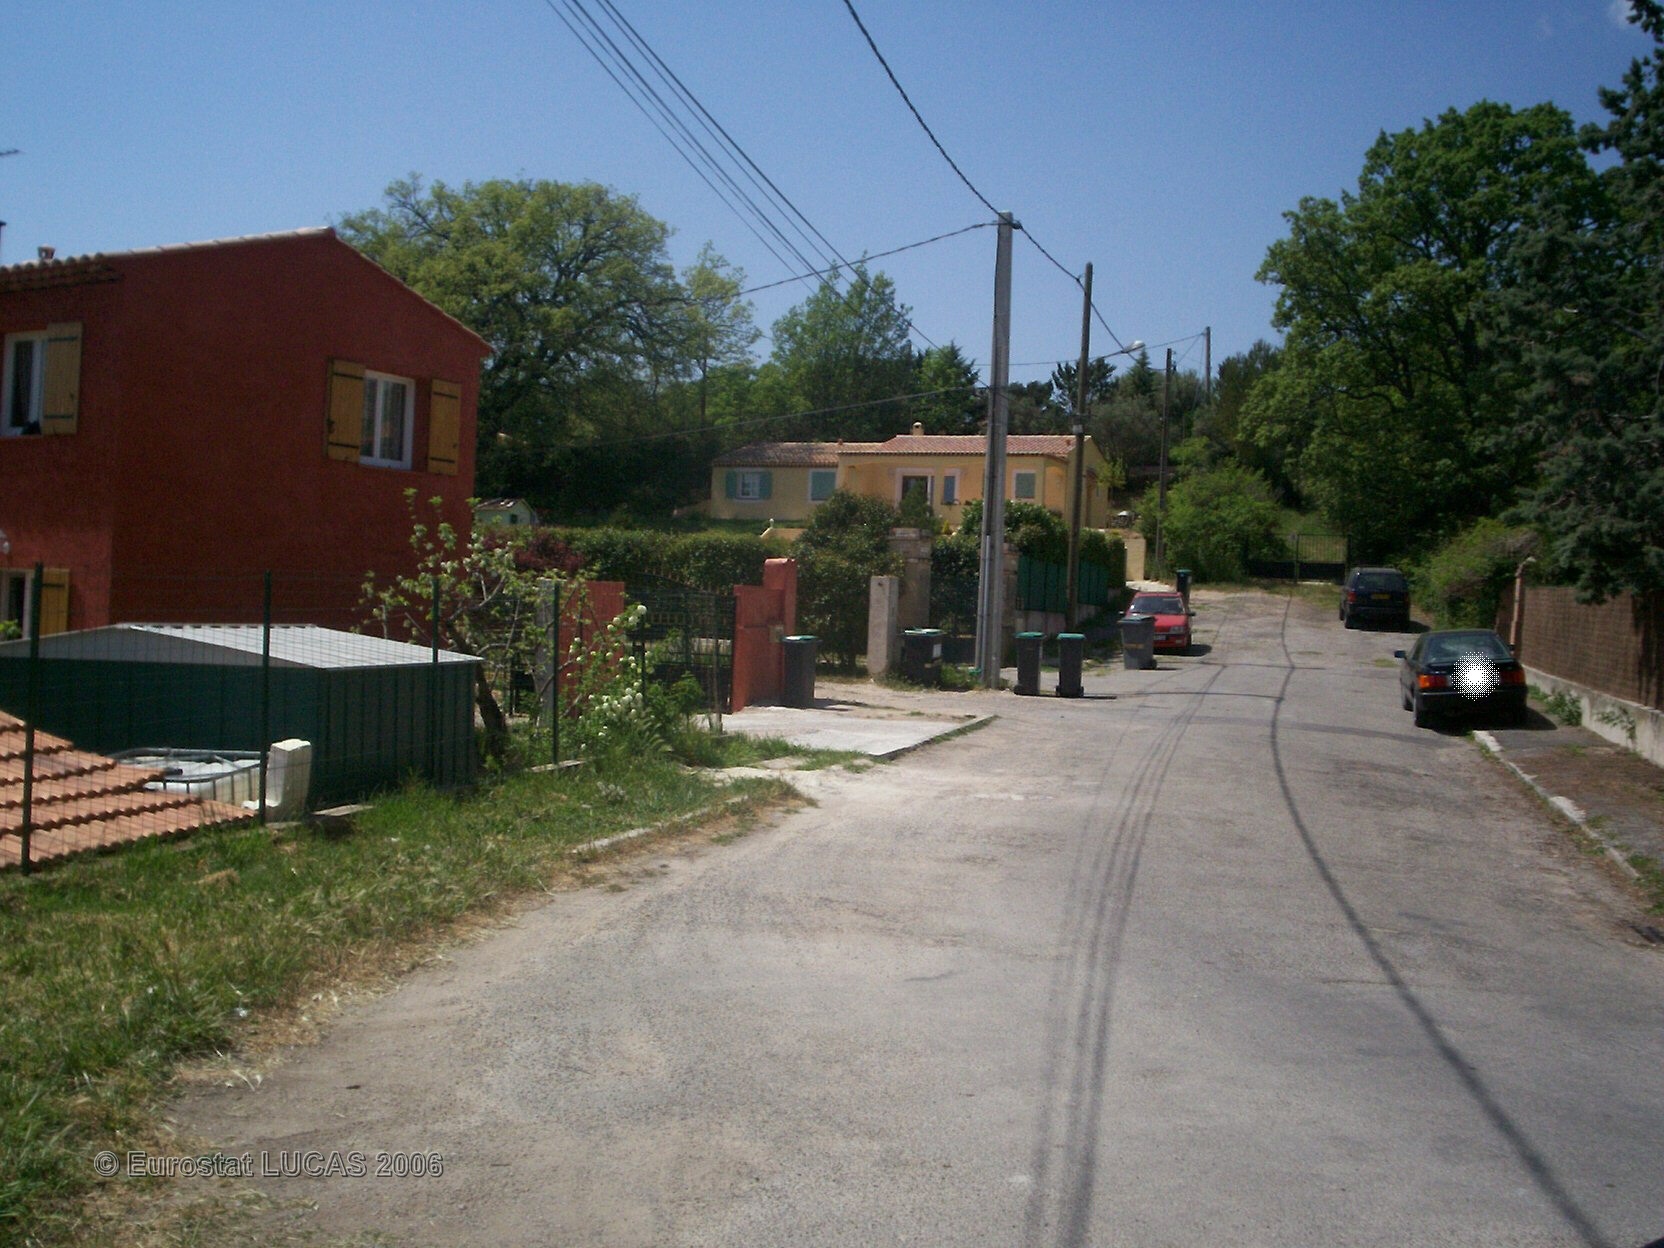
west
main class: Grassland
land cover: Grassland with sparse tree/shrub cover
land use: Residential
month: April
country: FR
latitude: 43.2980
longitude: 5.5604
